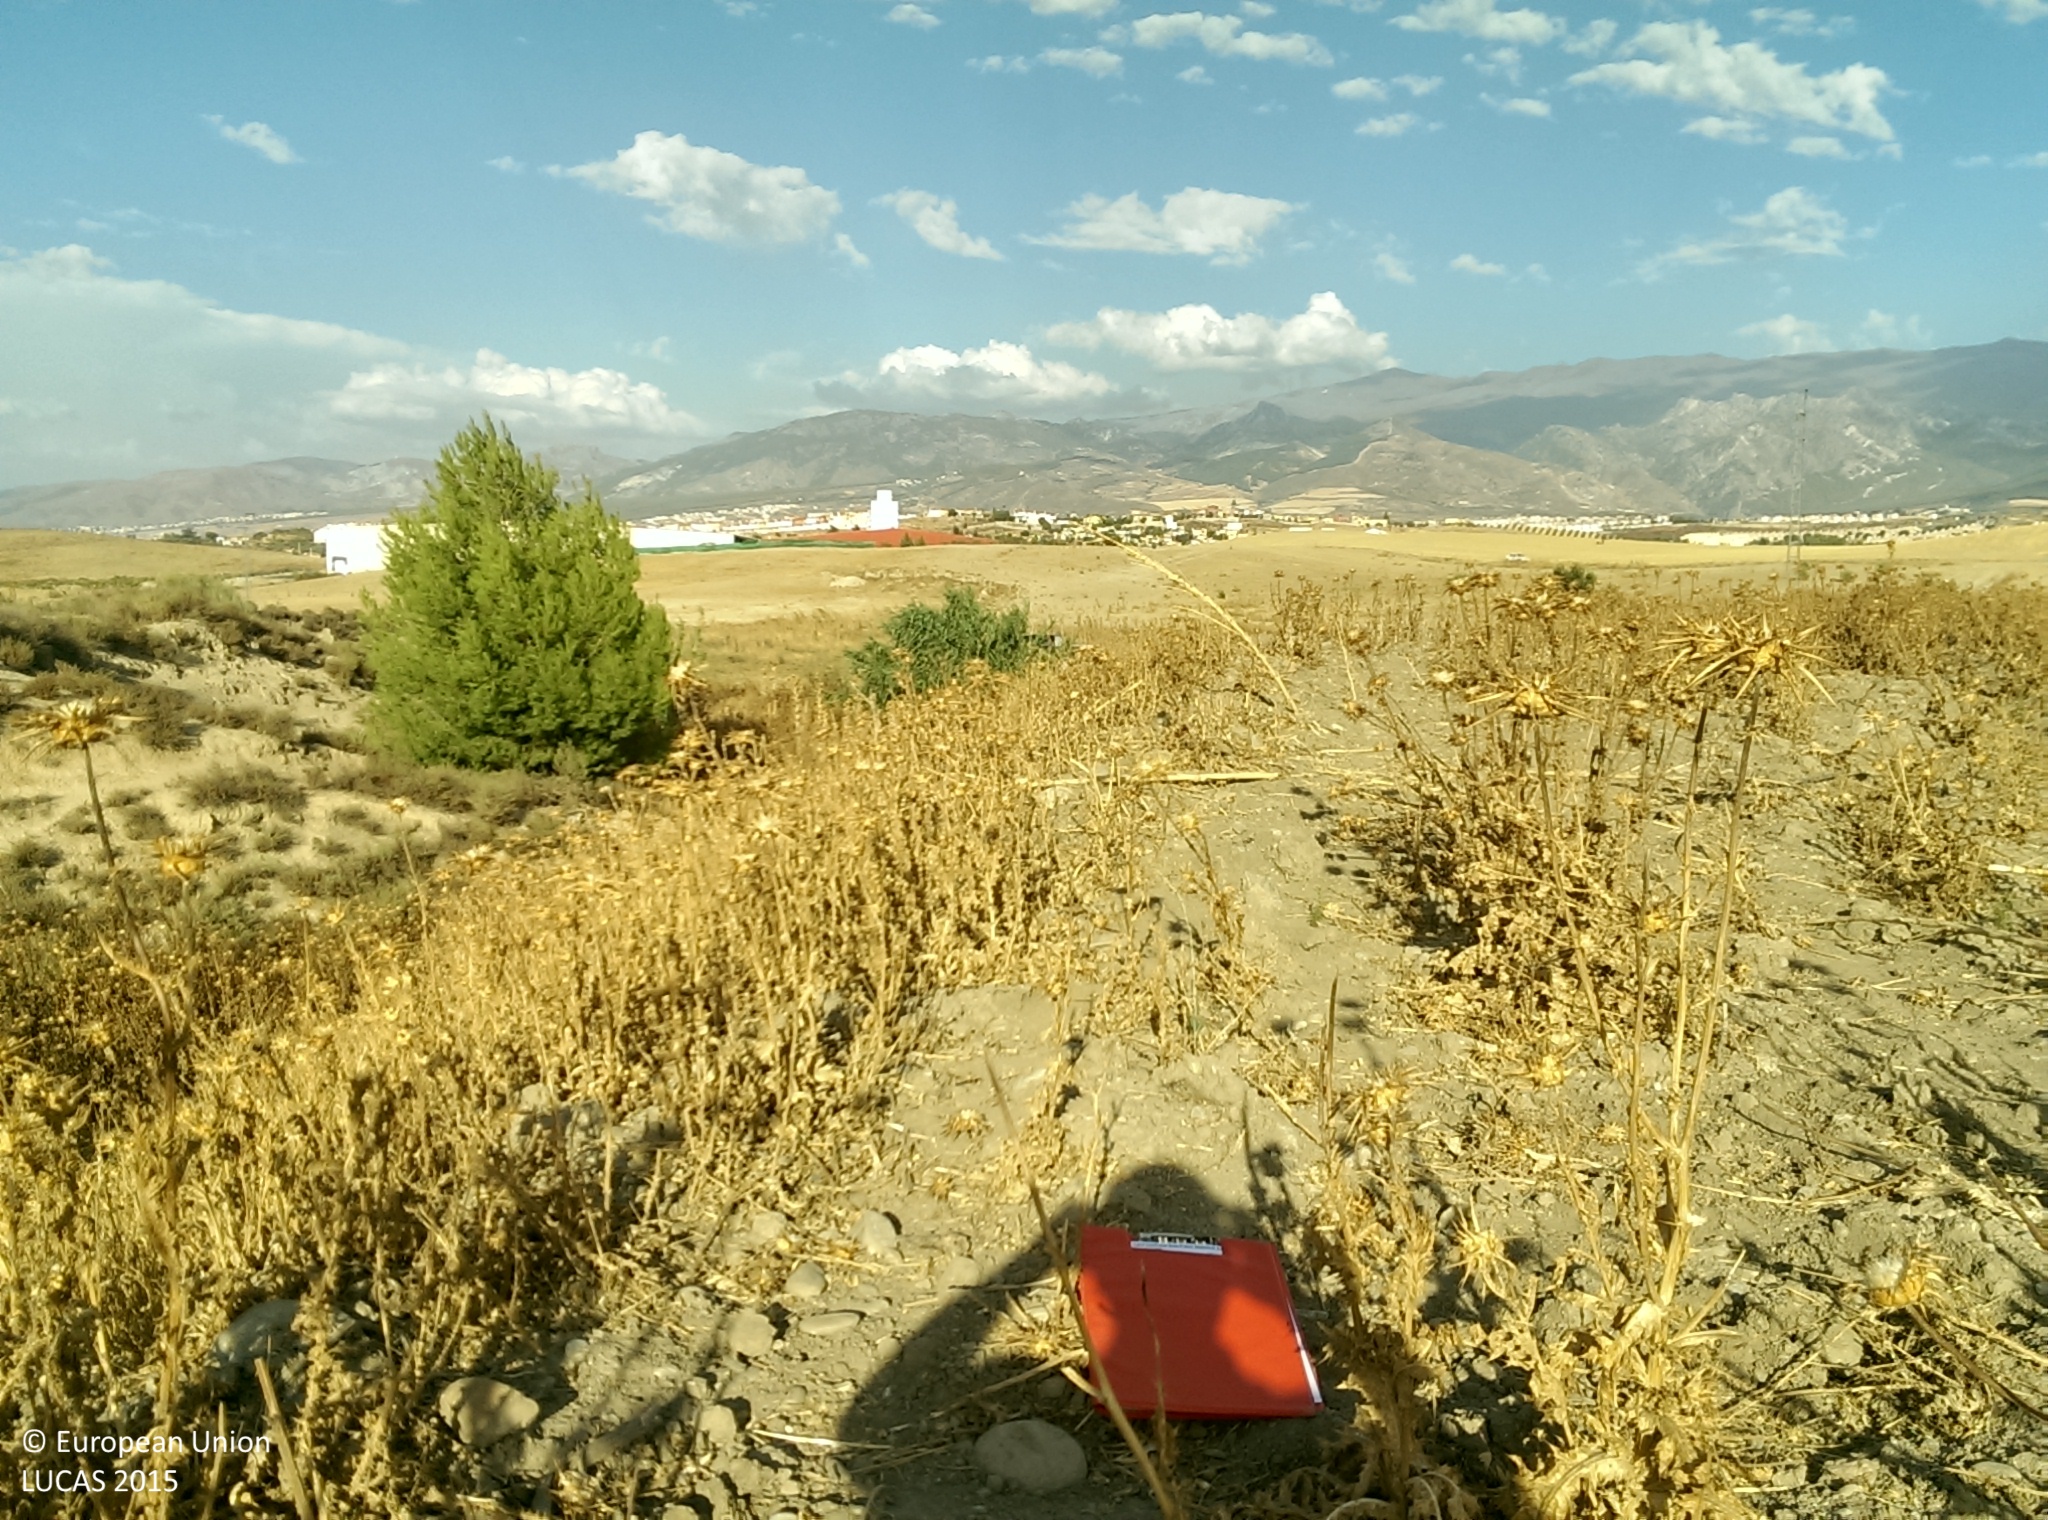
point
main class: Grassland
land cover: Spontaneously vegetated surfaces
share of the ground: 10 - 25 %
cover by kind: unconsolidated bare surface 90 %, herbaceous plants 10 %
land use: Agriculture (excluding fallow land and kitchen gardens)
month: August
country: ES
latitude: 37.0878
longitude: -3.6570
